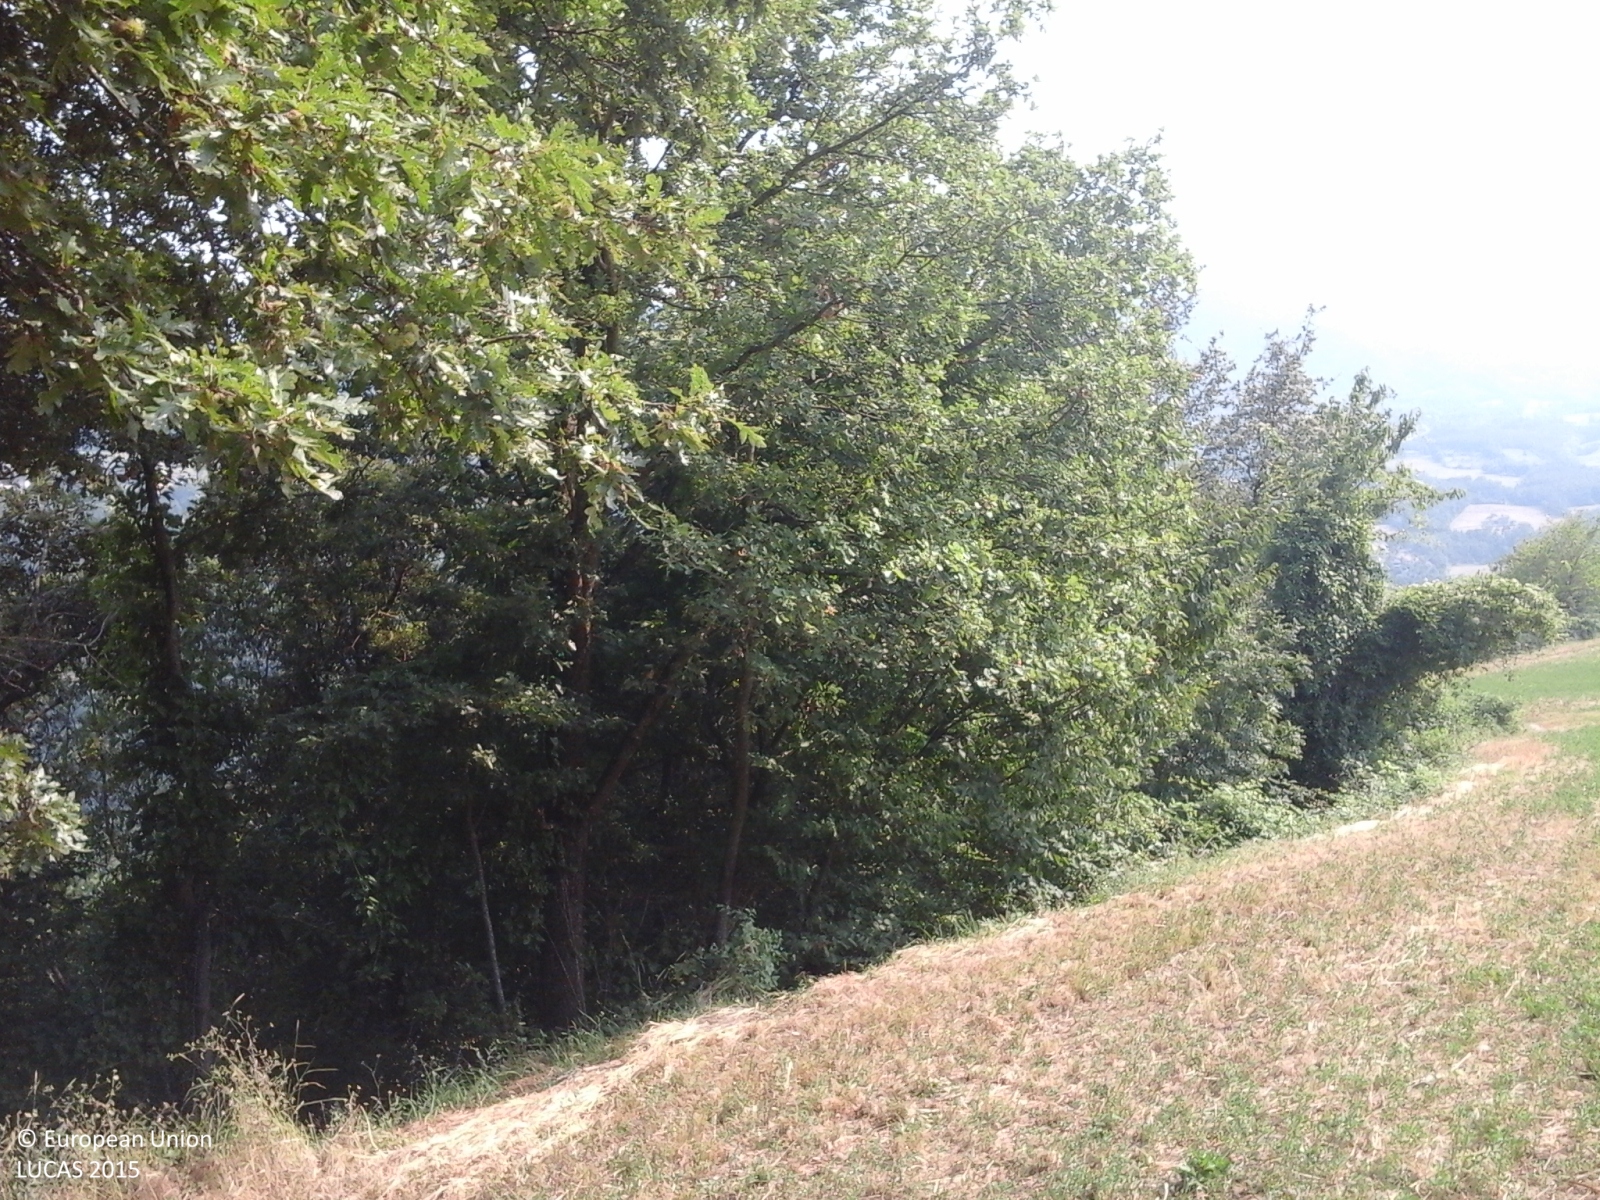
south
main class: Woodland
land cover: Broadleaved woodland
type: thermophilous deciduous forest
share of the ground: 50 - 75 %
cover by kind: broadleaved forest trees 75 %, shrubs 15 %, herbaceous plants 10 %
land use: Forestry
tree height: > 5 m
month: July
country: IT
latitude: 44.3669
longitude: 10.5884
